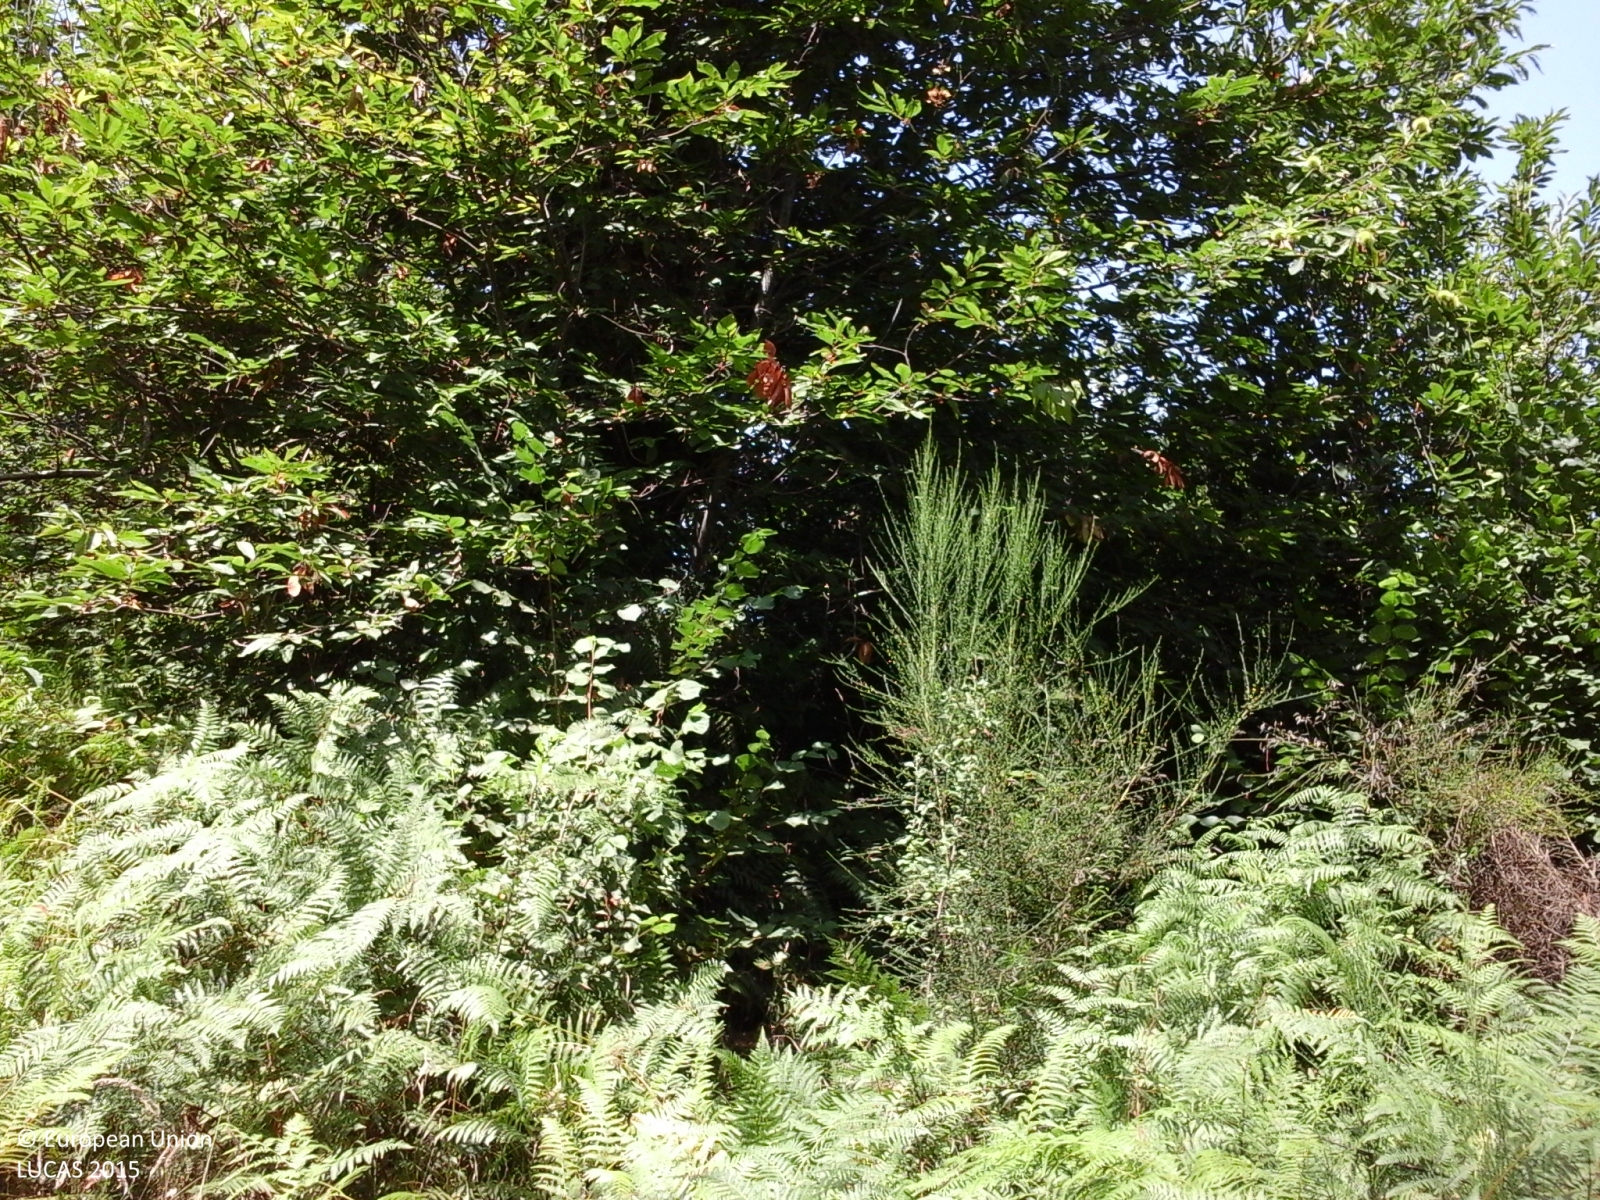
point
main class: Woodland
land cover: Broadleaved woodland
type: thermophilous deciduous forest
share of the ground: > 75 %
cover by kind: broadleaved forest trees 90 %, shrubs 5 %, herbaceous plants 5 %
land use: Semi-natural and natural areas not in use
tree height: > 5 m
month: July
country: IT
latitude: 41.5978
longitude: 12.9758
